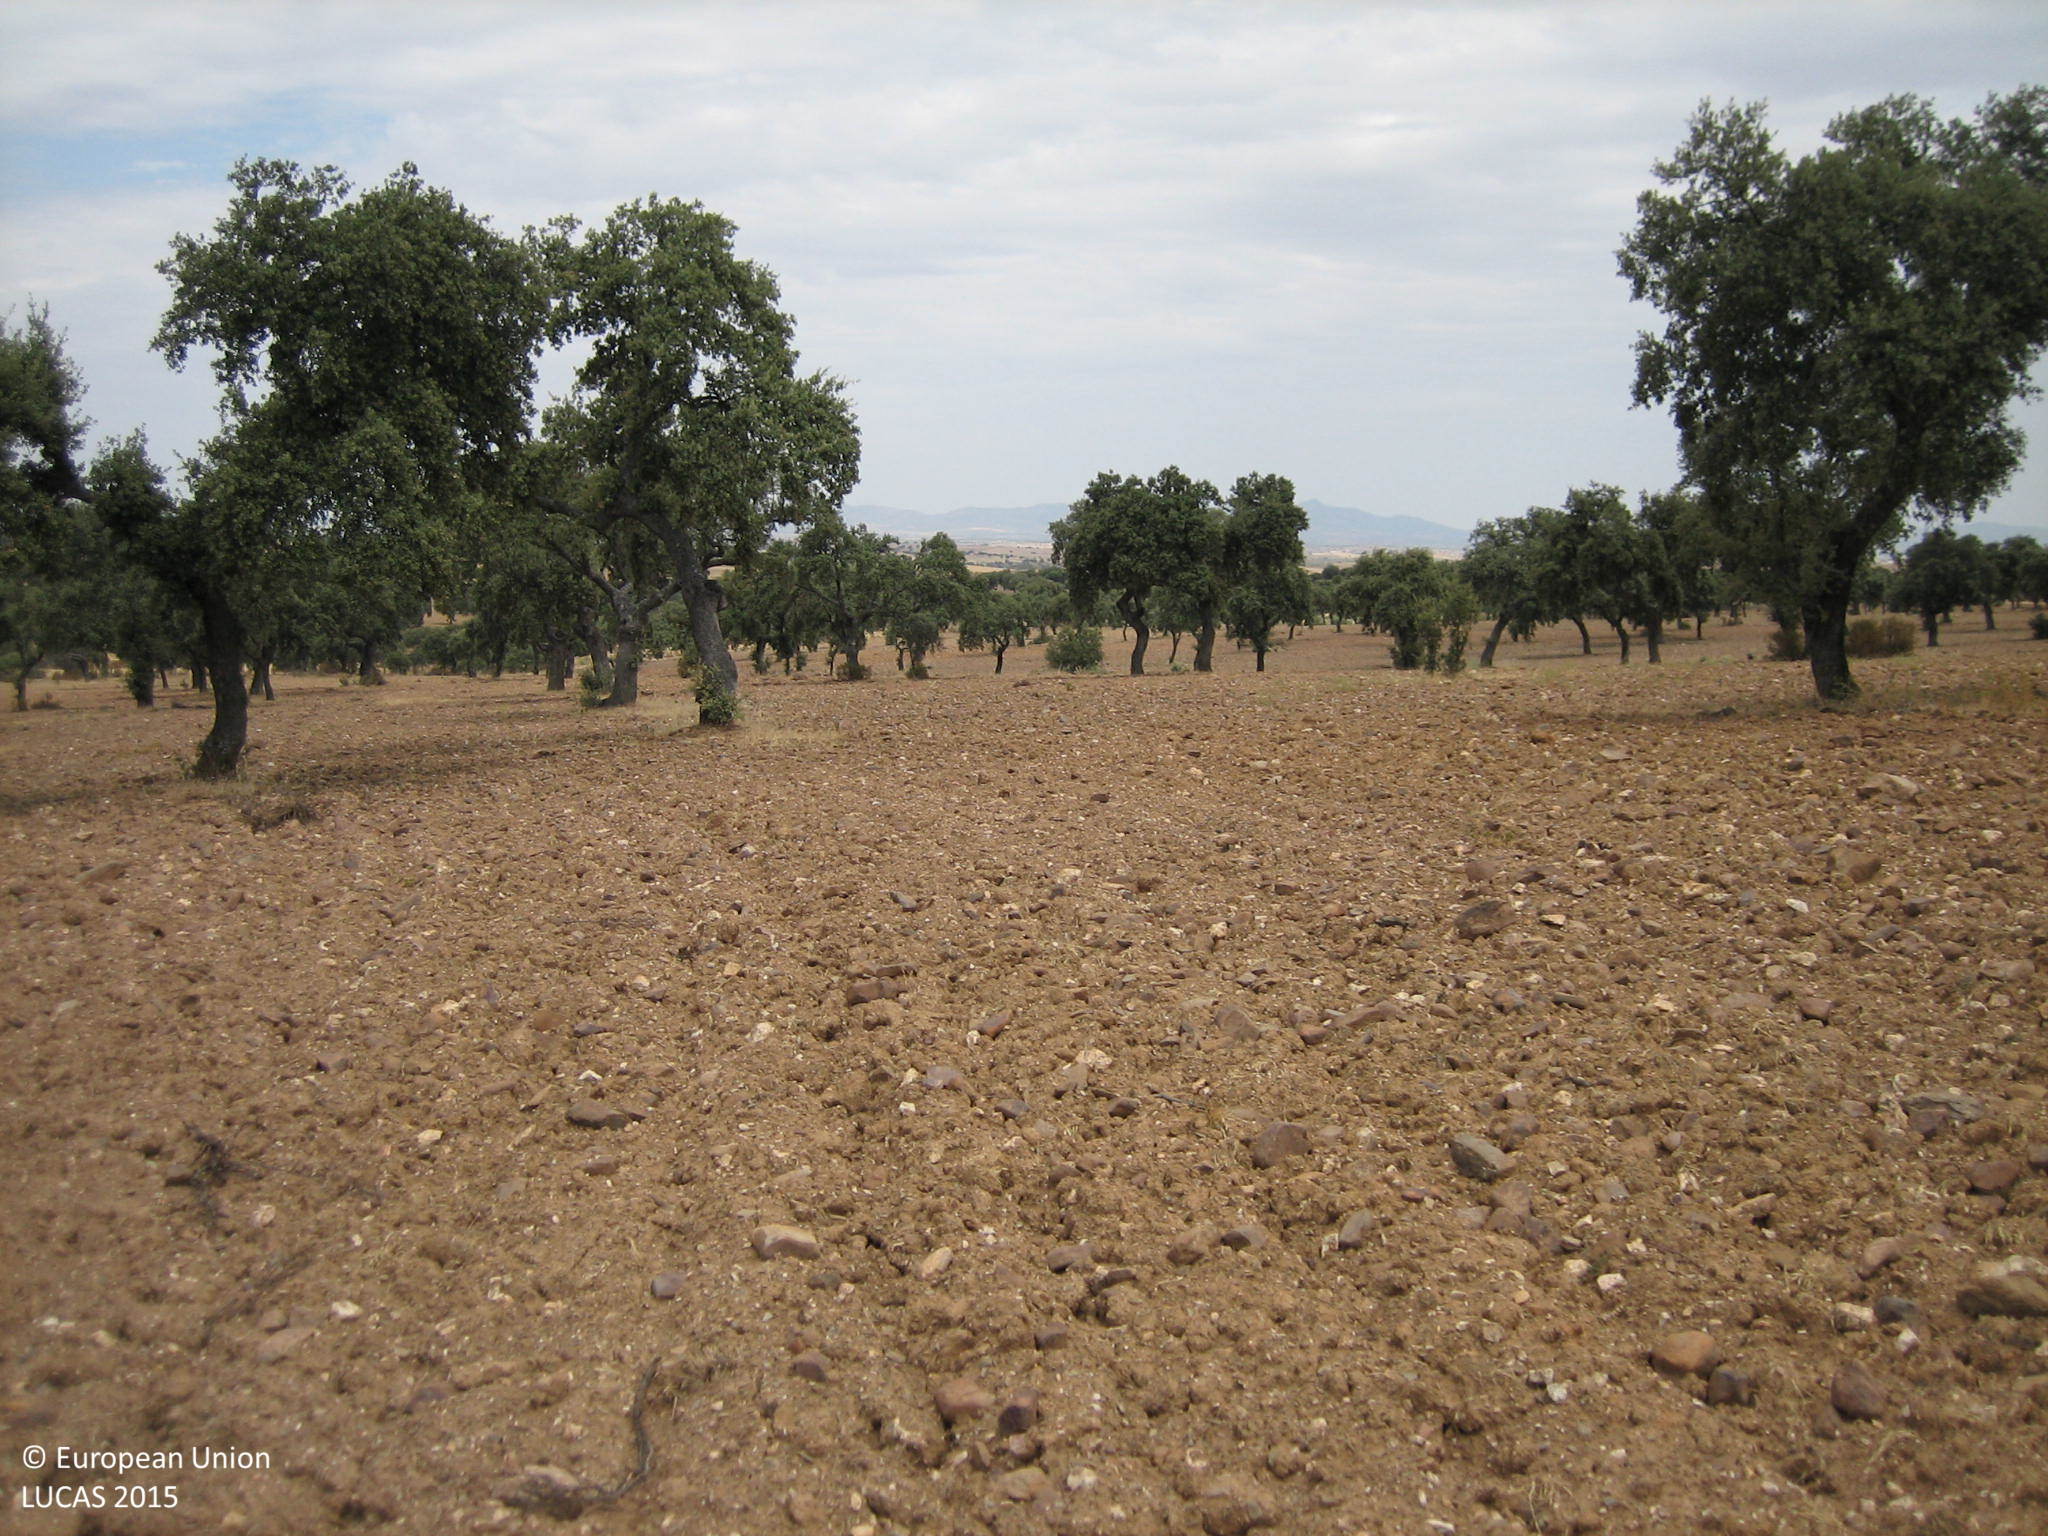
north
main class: Woodland
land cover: Broadleaved woodland
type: broadleaved evergreen forest
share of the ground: 10 - 25 %
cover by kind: unconsolidated bare surface 90 %, broadleaved forest trees 10 %
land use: Forestry
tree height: > 5 m
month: July
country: ES
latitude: 38.4798
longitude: -5.3591
